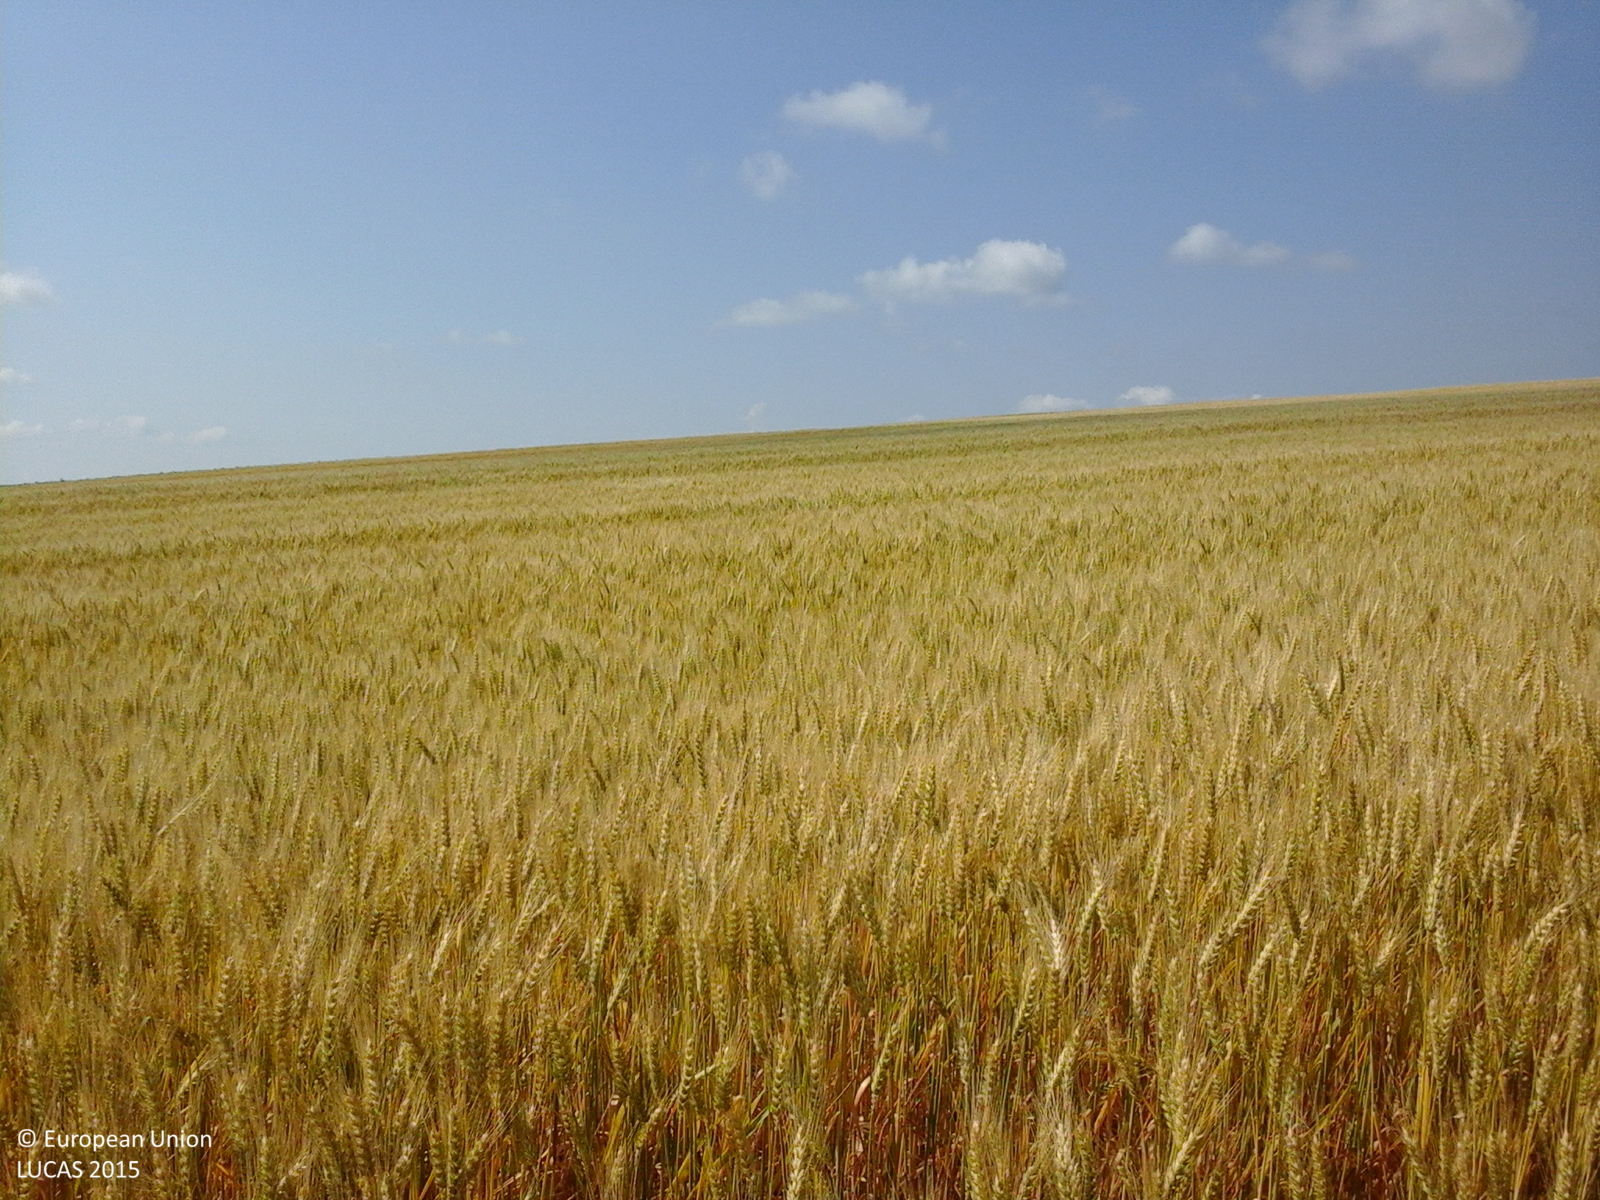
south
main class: Cropland
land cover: Common wheat
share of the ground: > 75 %
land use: Agriculture (excluding fallow land and kitchen gardens)
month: June
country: RO
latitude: 47.7534
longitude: 27.0059
